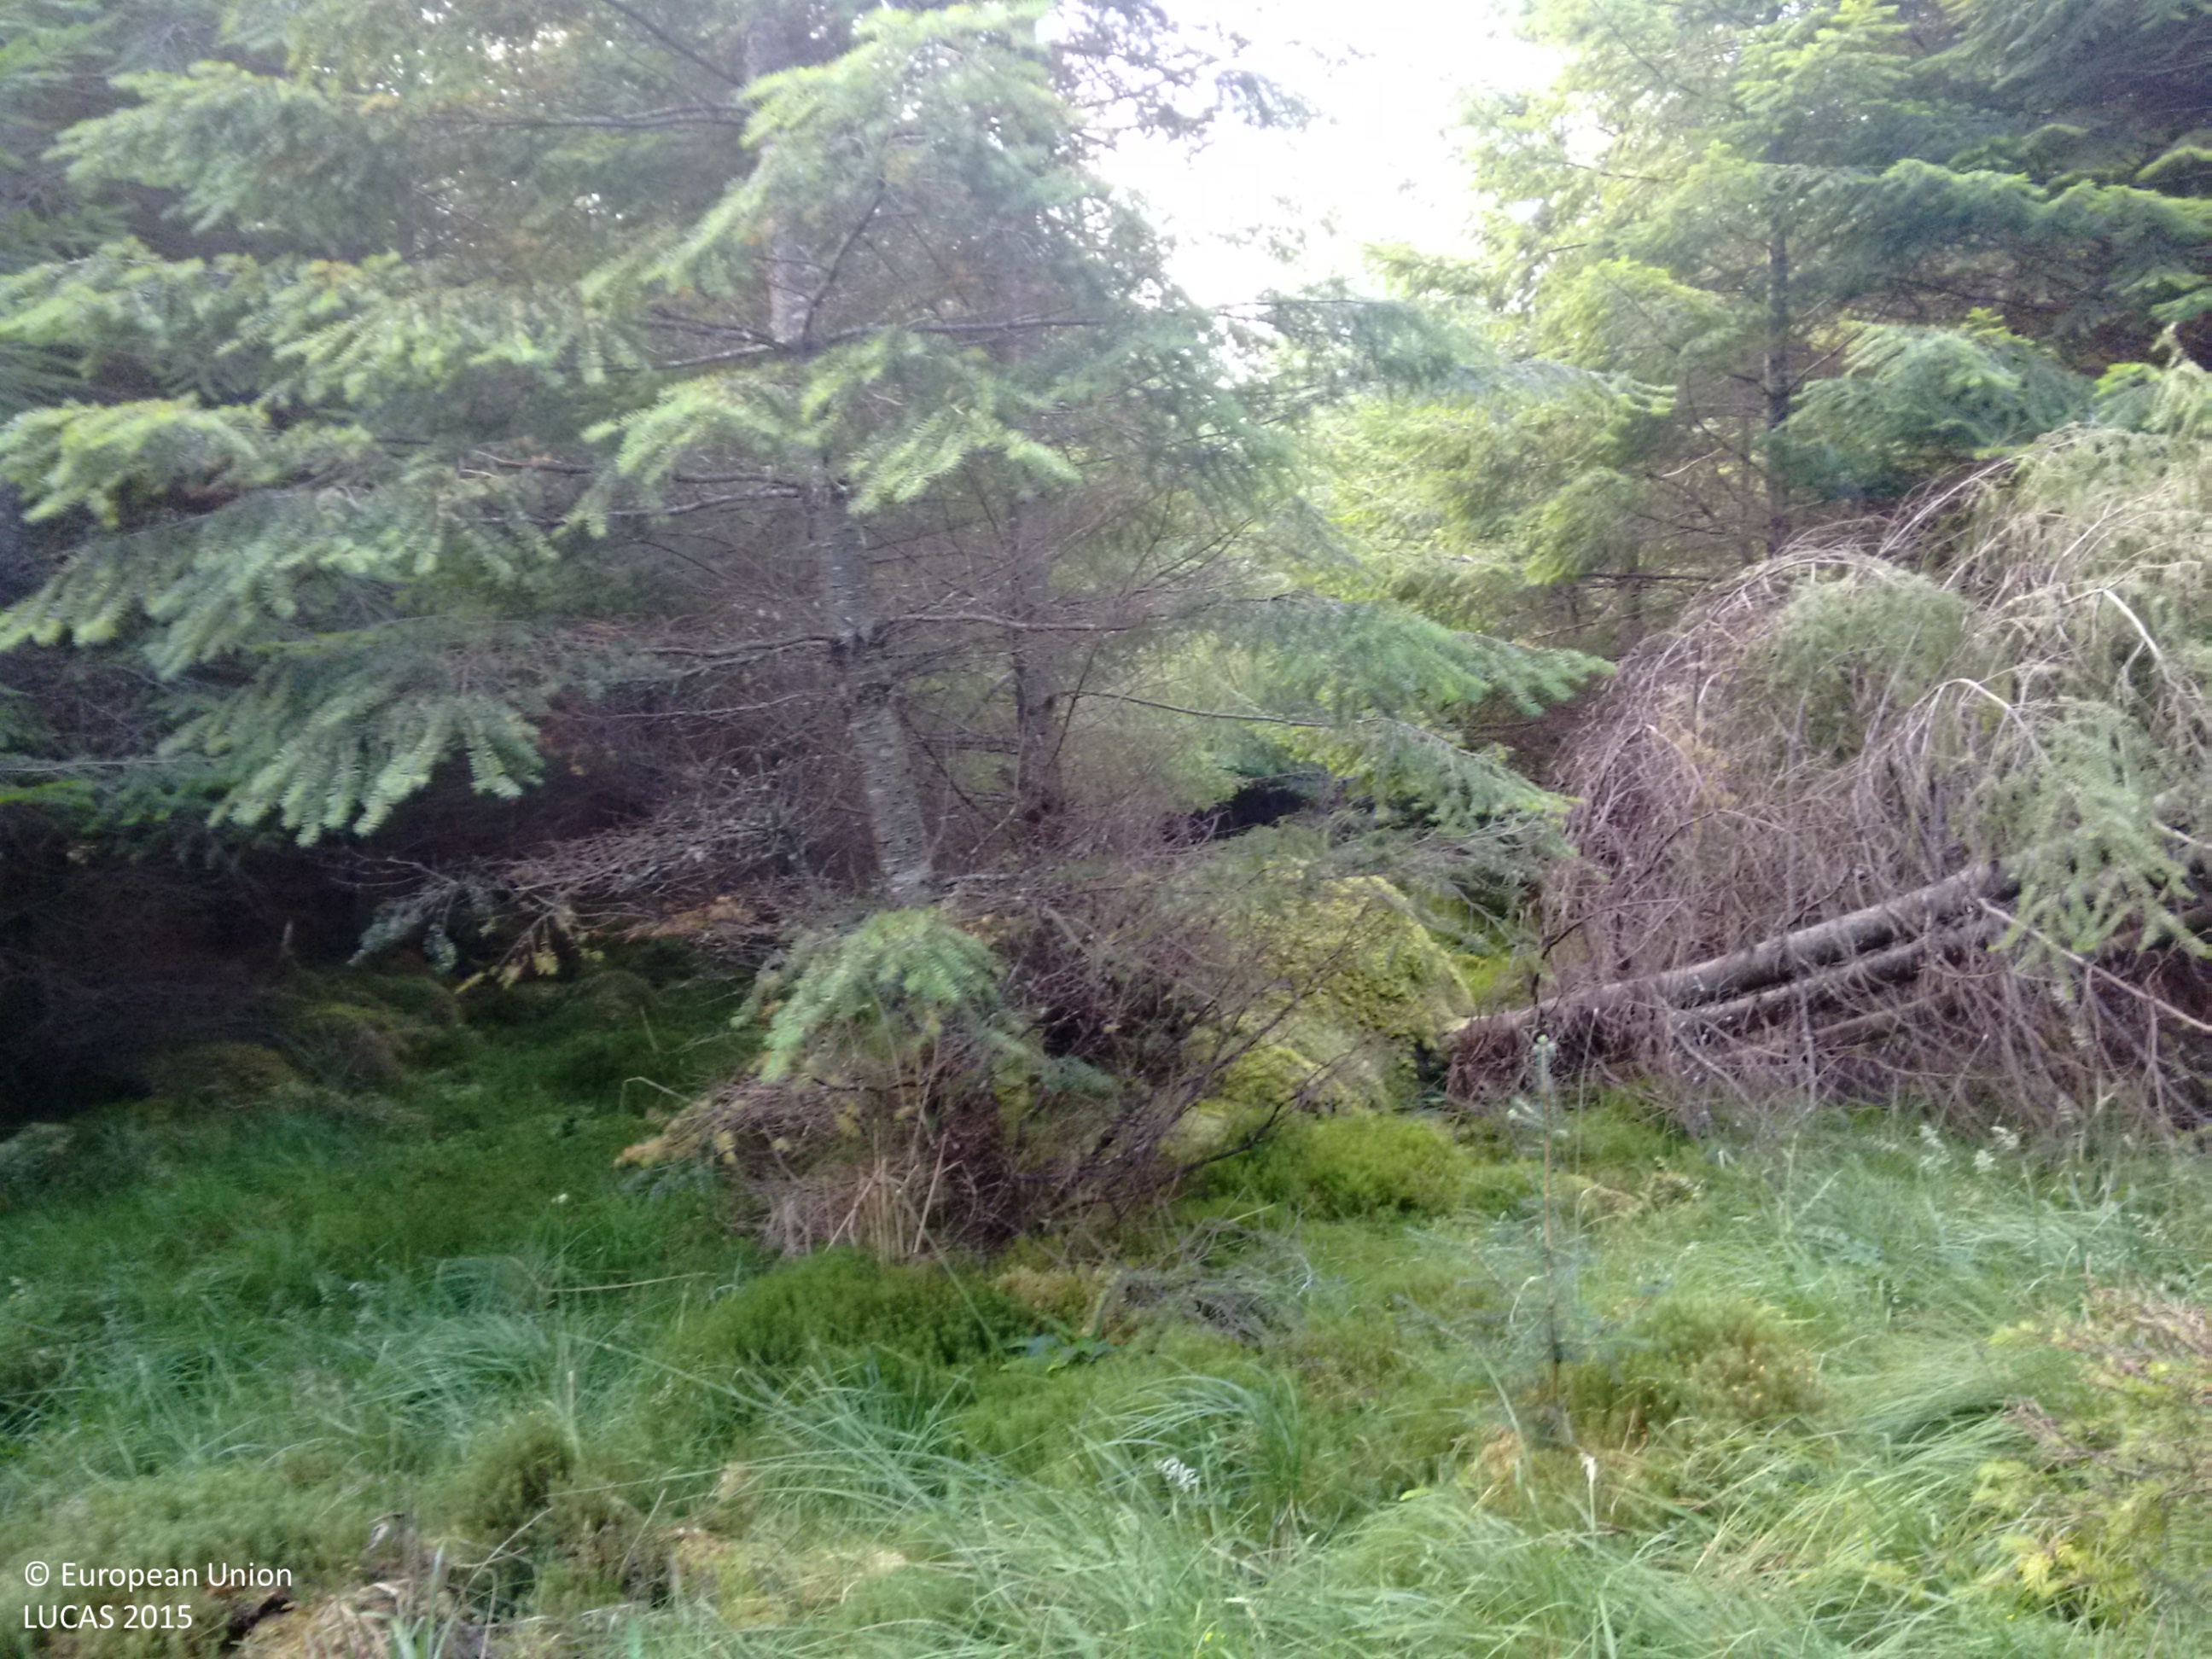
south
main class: Woodland
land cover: Spruce dominated coniferous woodland
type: exotic forest
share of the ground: > 75 %
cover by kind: coniferous forest trees 100 %
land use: Forestry
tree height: > 5 m
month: September
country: GB
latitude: 57.6445
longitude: -4.6868
